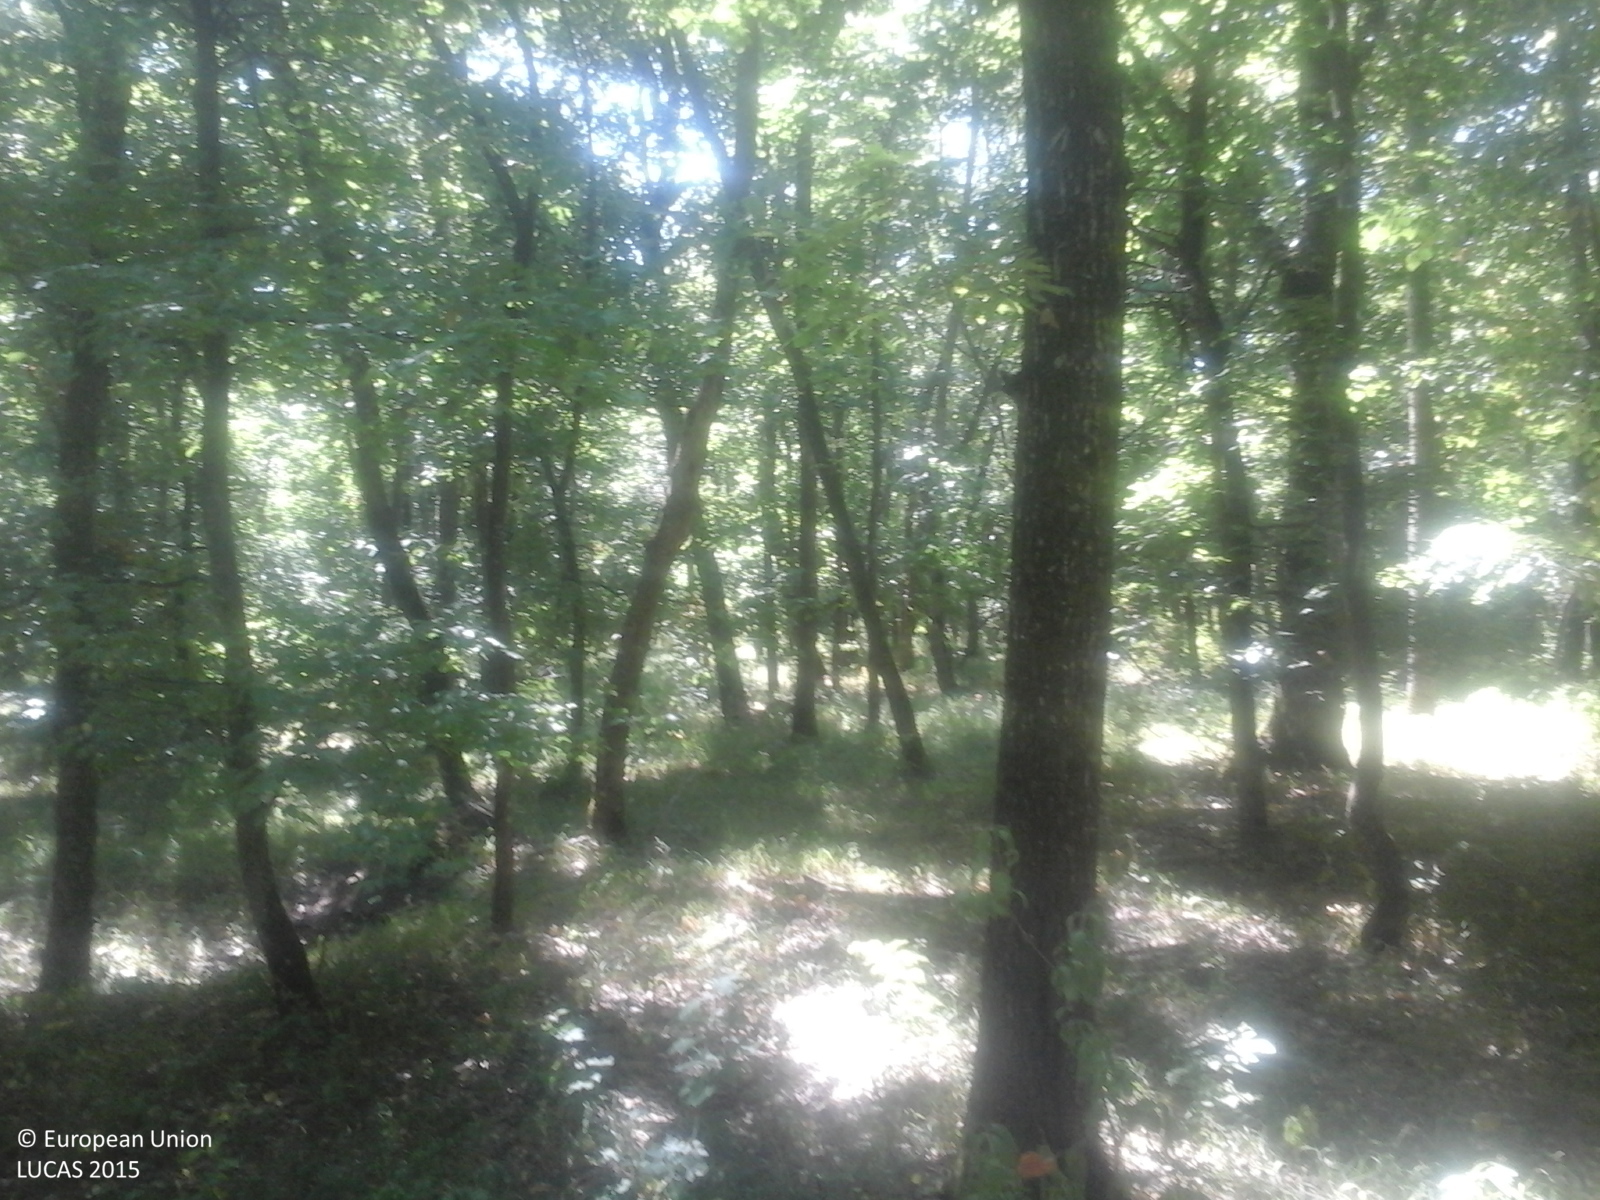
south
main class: Woodland
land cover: Broadleaved woodland
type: acidophilous oak and oak-birch forest
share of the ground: > 75 %
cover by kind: broadleaved forest trees 100 %
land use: Forestry
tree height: > 5 m
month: July
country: RO
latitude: 46.5096
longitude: 27.9670
